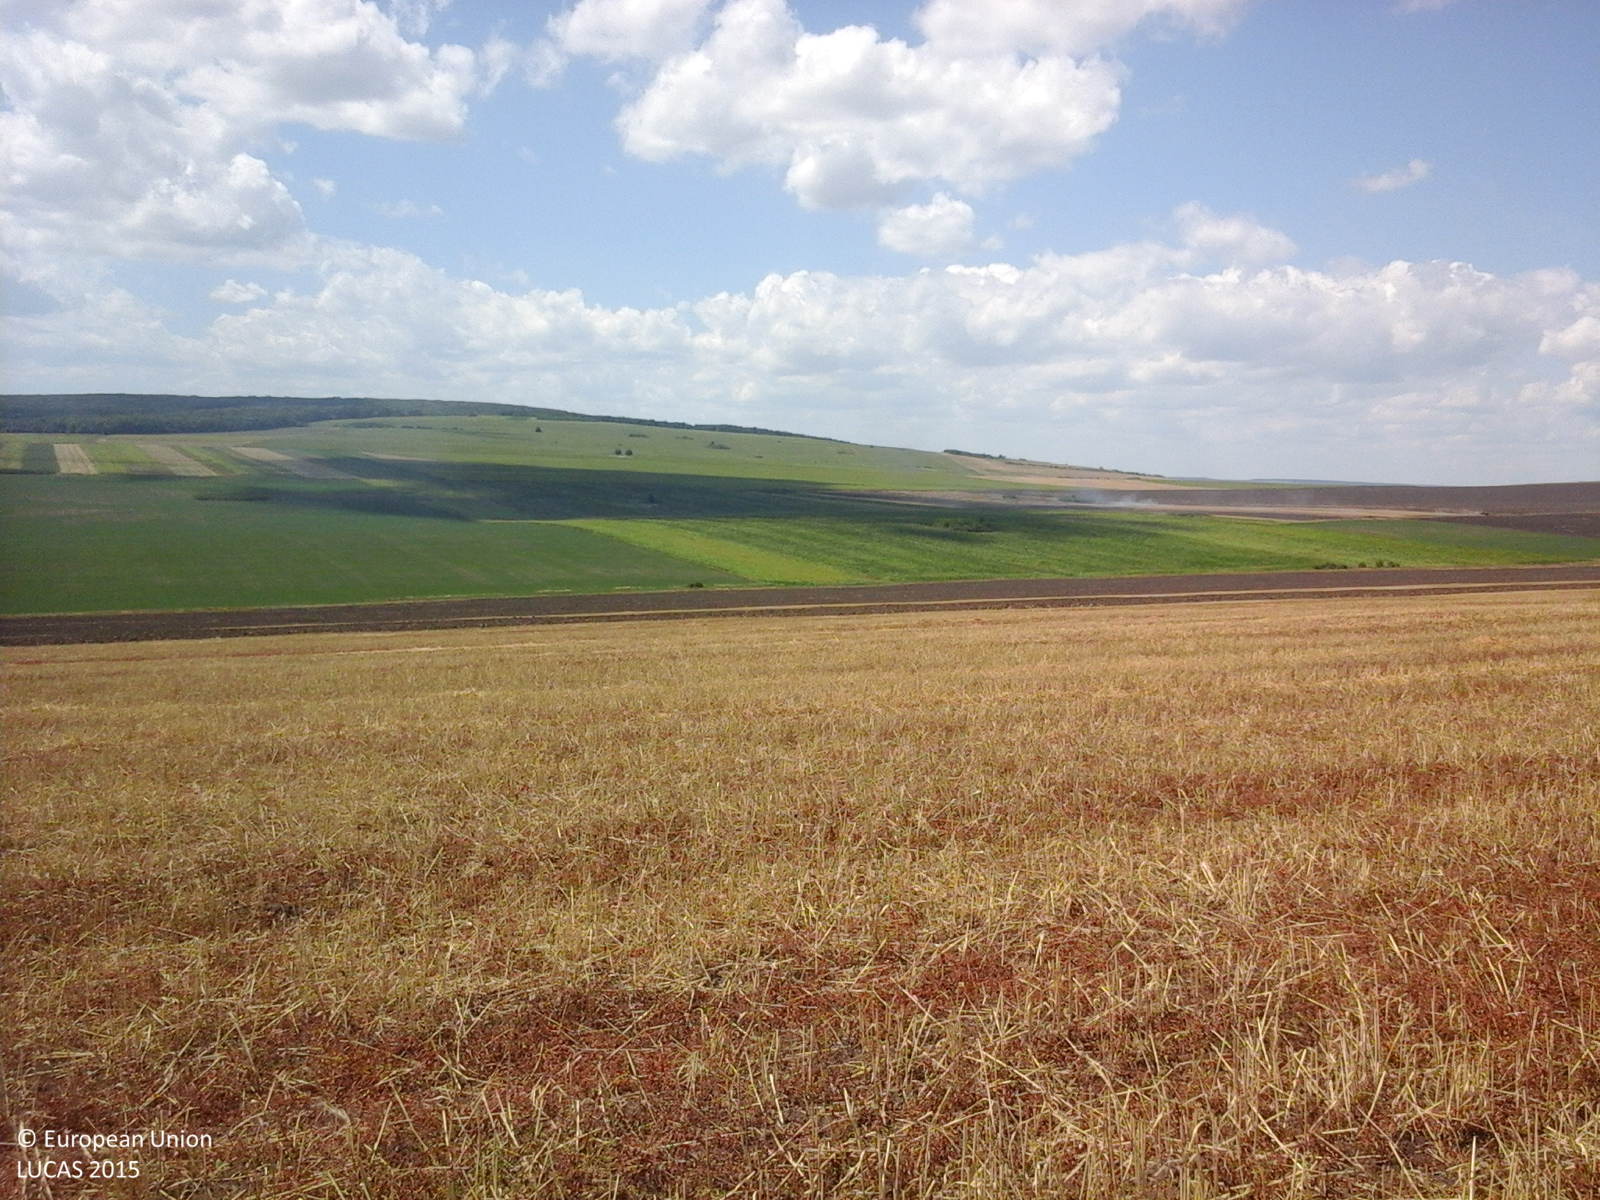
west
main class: Cropland
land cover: Common wheat
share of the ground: > 75 %
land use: Agriculture (excluding fallow land and kitchen gardens)
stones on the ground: < 10 %
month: July
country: RO
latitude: 46.4051
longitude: 27.9309
